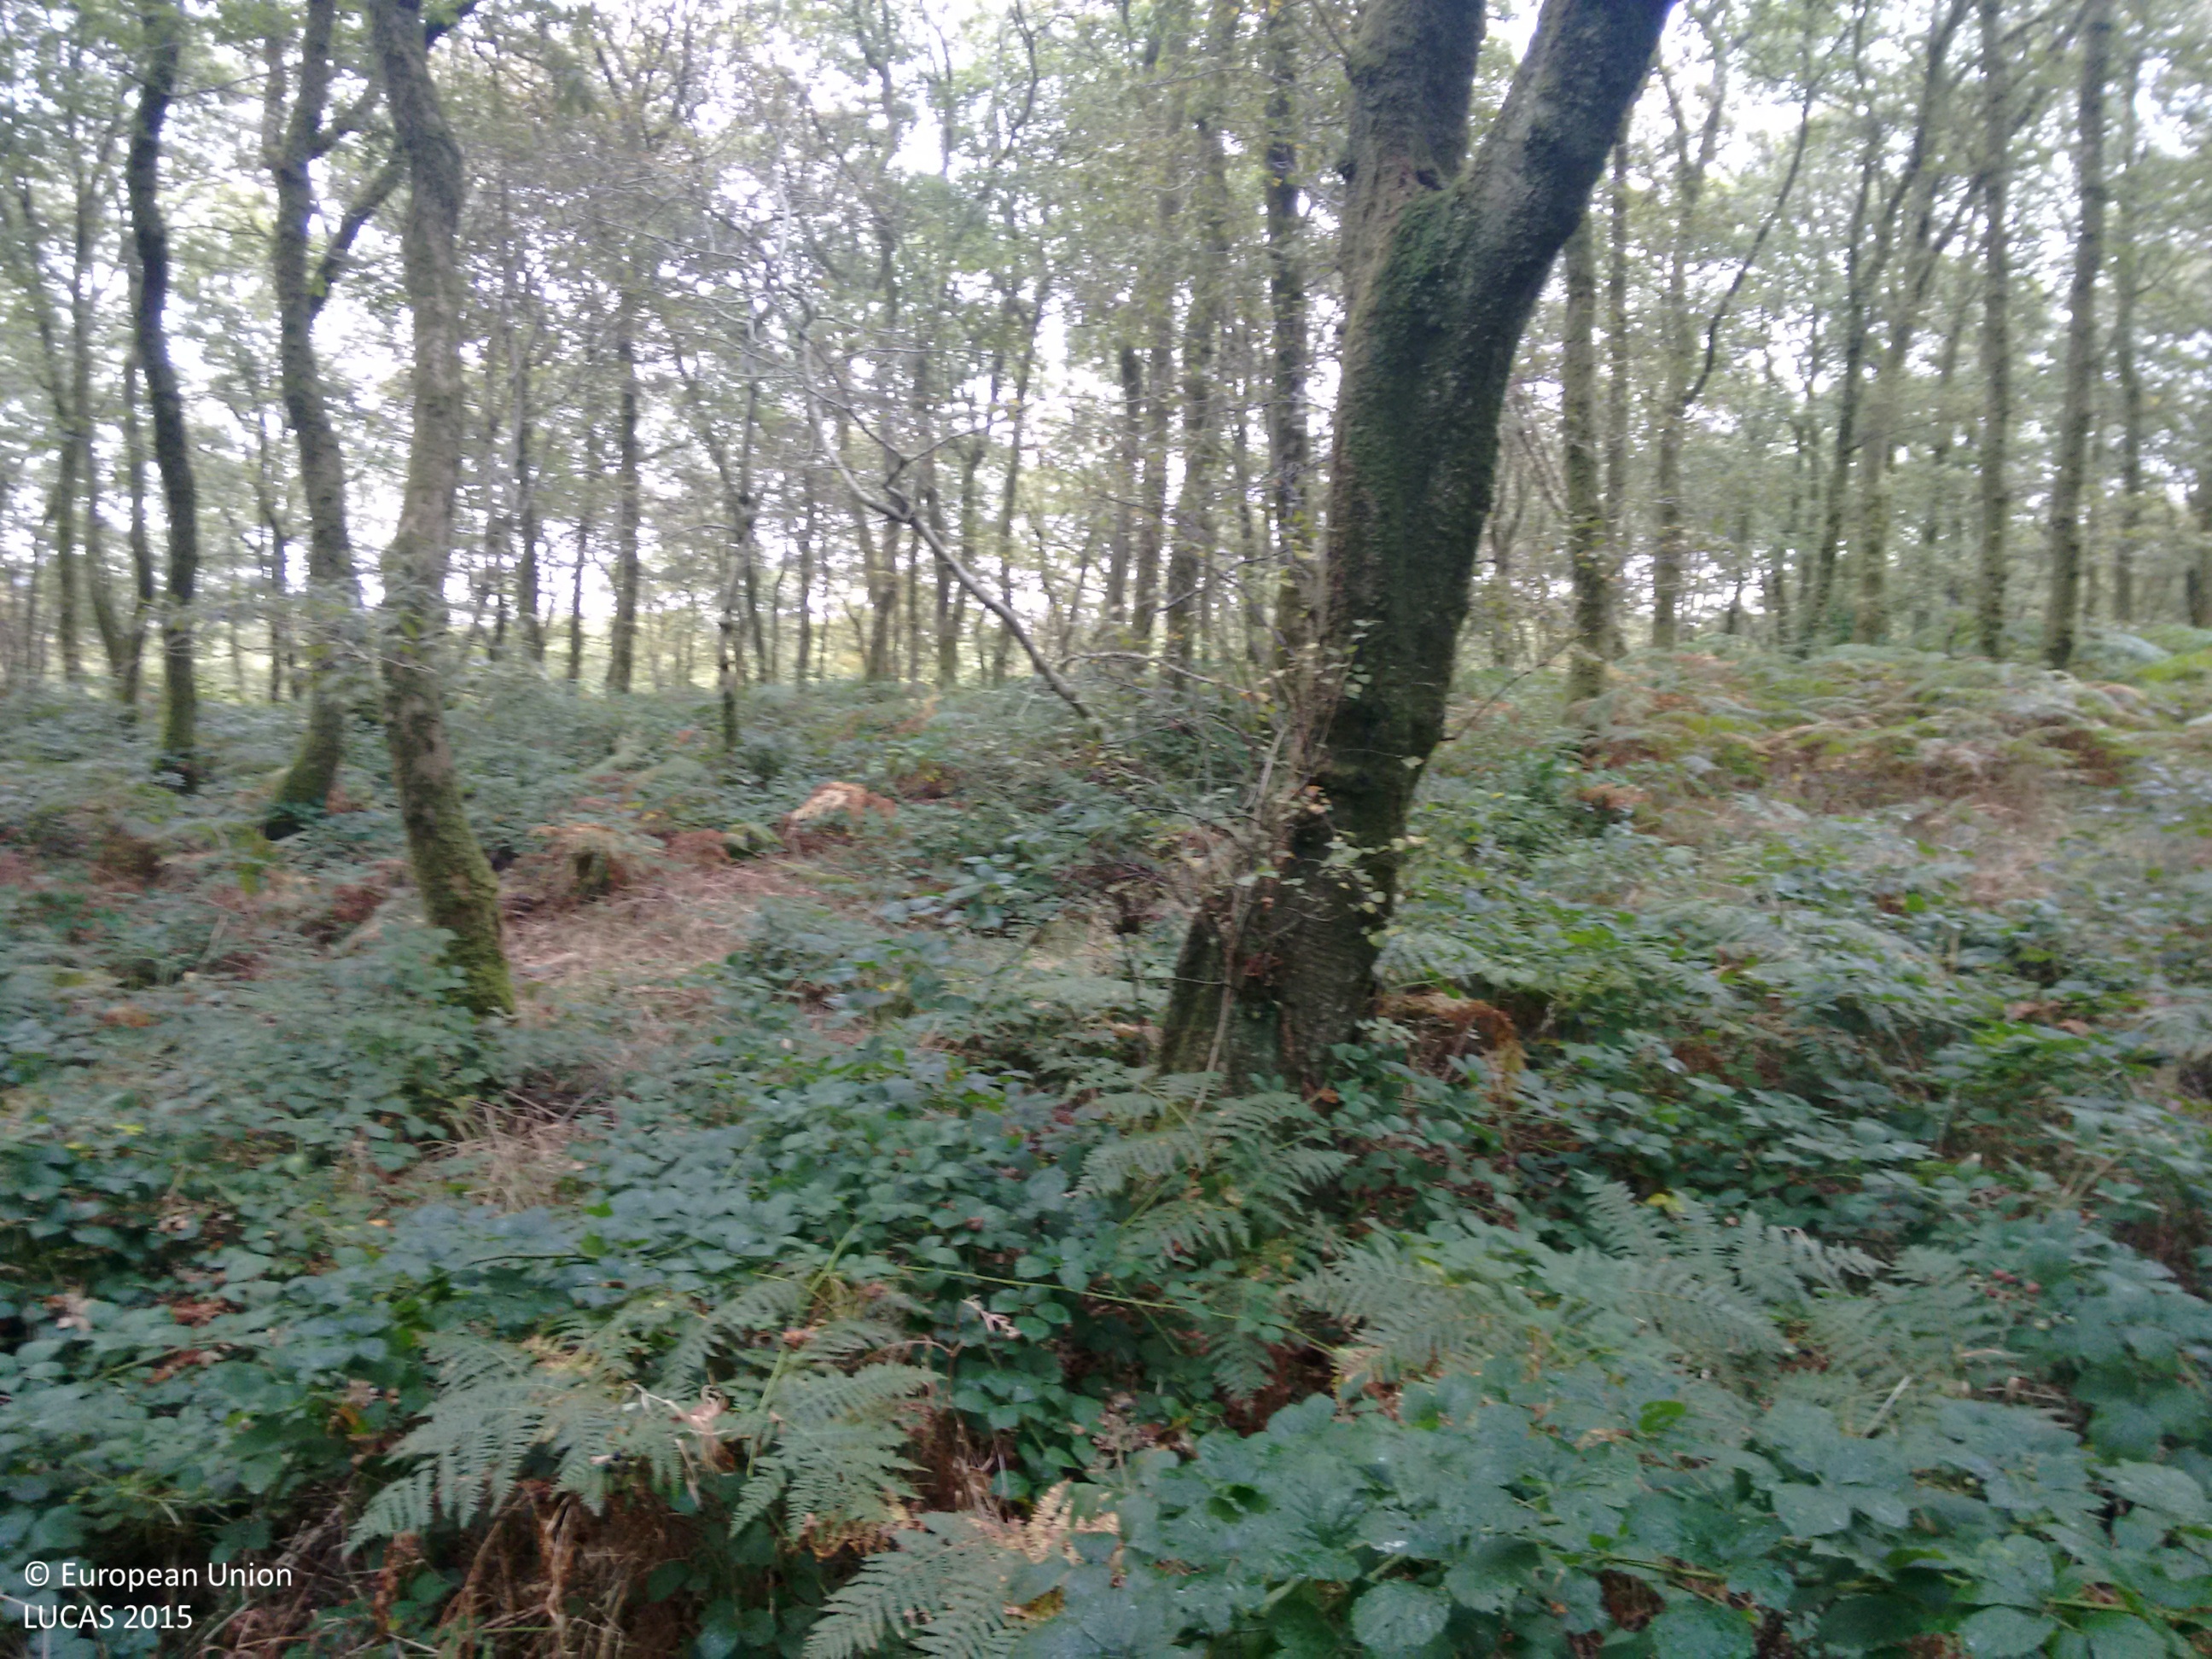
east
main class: Woodland
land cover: Broadleaved woodland
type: acidophilous oak and oak-birch forest
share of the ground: > 75 %
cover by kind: broadleaved forest trees 100 %
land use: Semi-natural and natural areas not in use
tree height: > 5 m
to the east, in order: Broadleaved woodland; Paved roads, cycling and walking lanes; Broadleaved woodland; Fences; Electric lines; Grassland without tree/shrub cover; Fences; Managed hedges; Grassland without tree/shrub cover; Artificial constructions in urban areas; Managed hedges; Electric lines; Grassland without tree/shrub cover
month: October
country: GB
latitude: 52.4093
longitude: -3.9262
